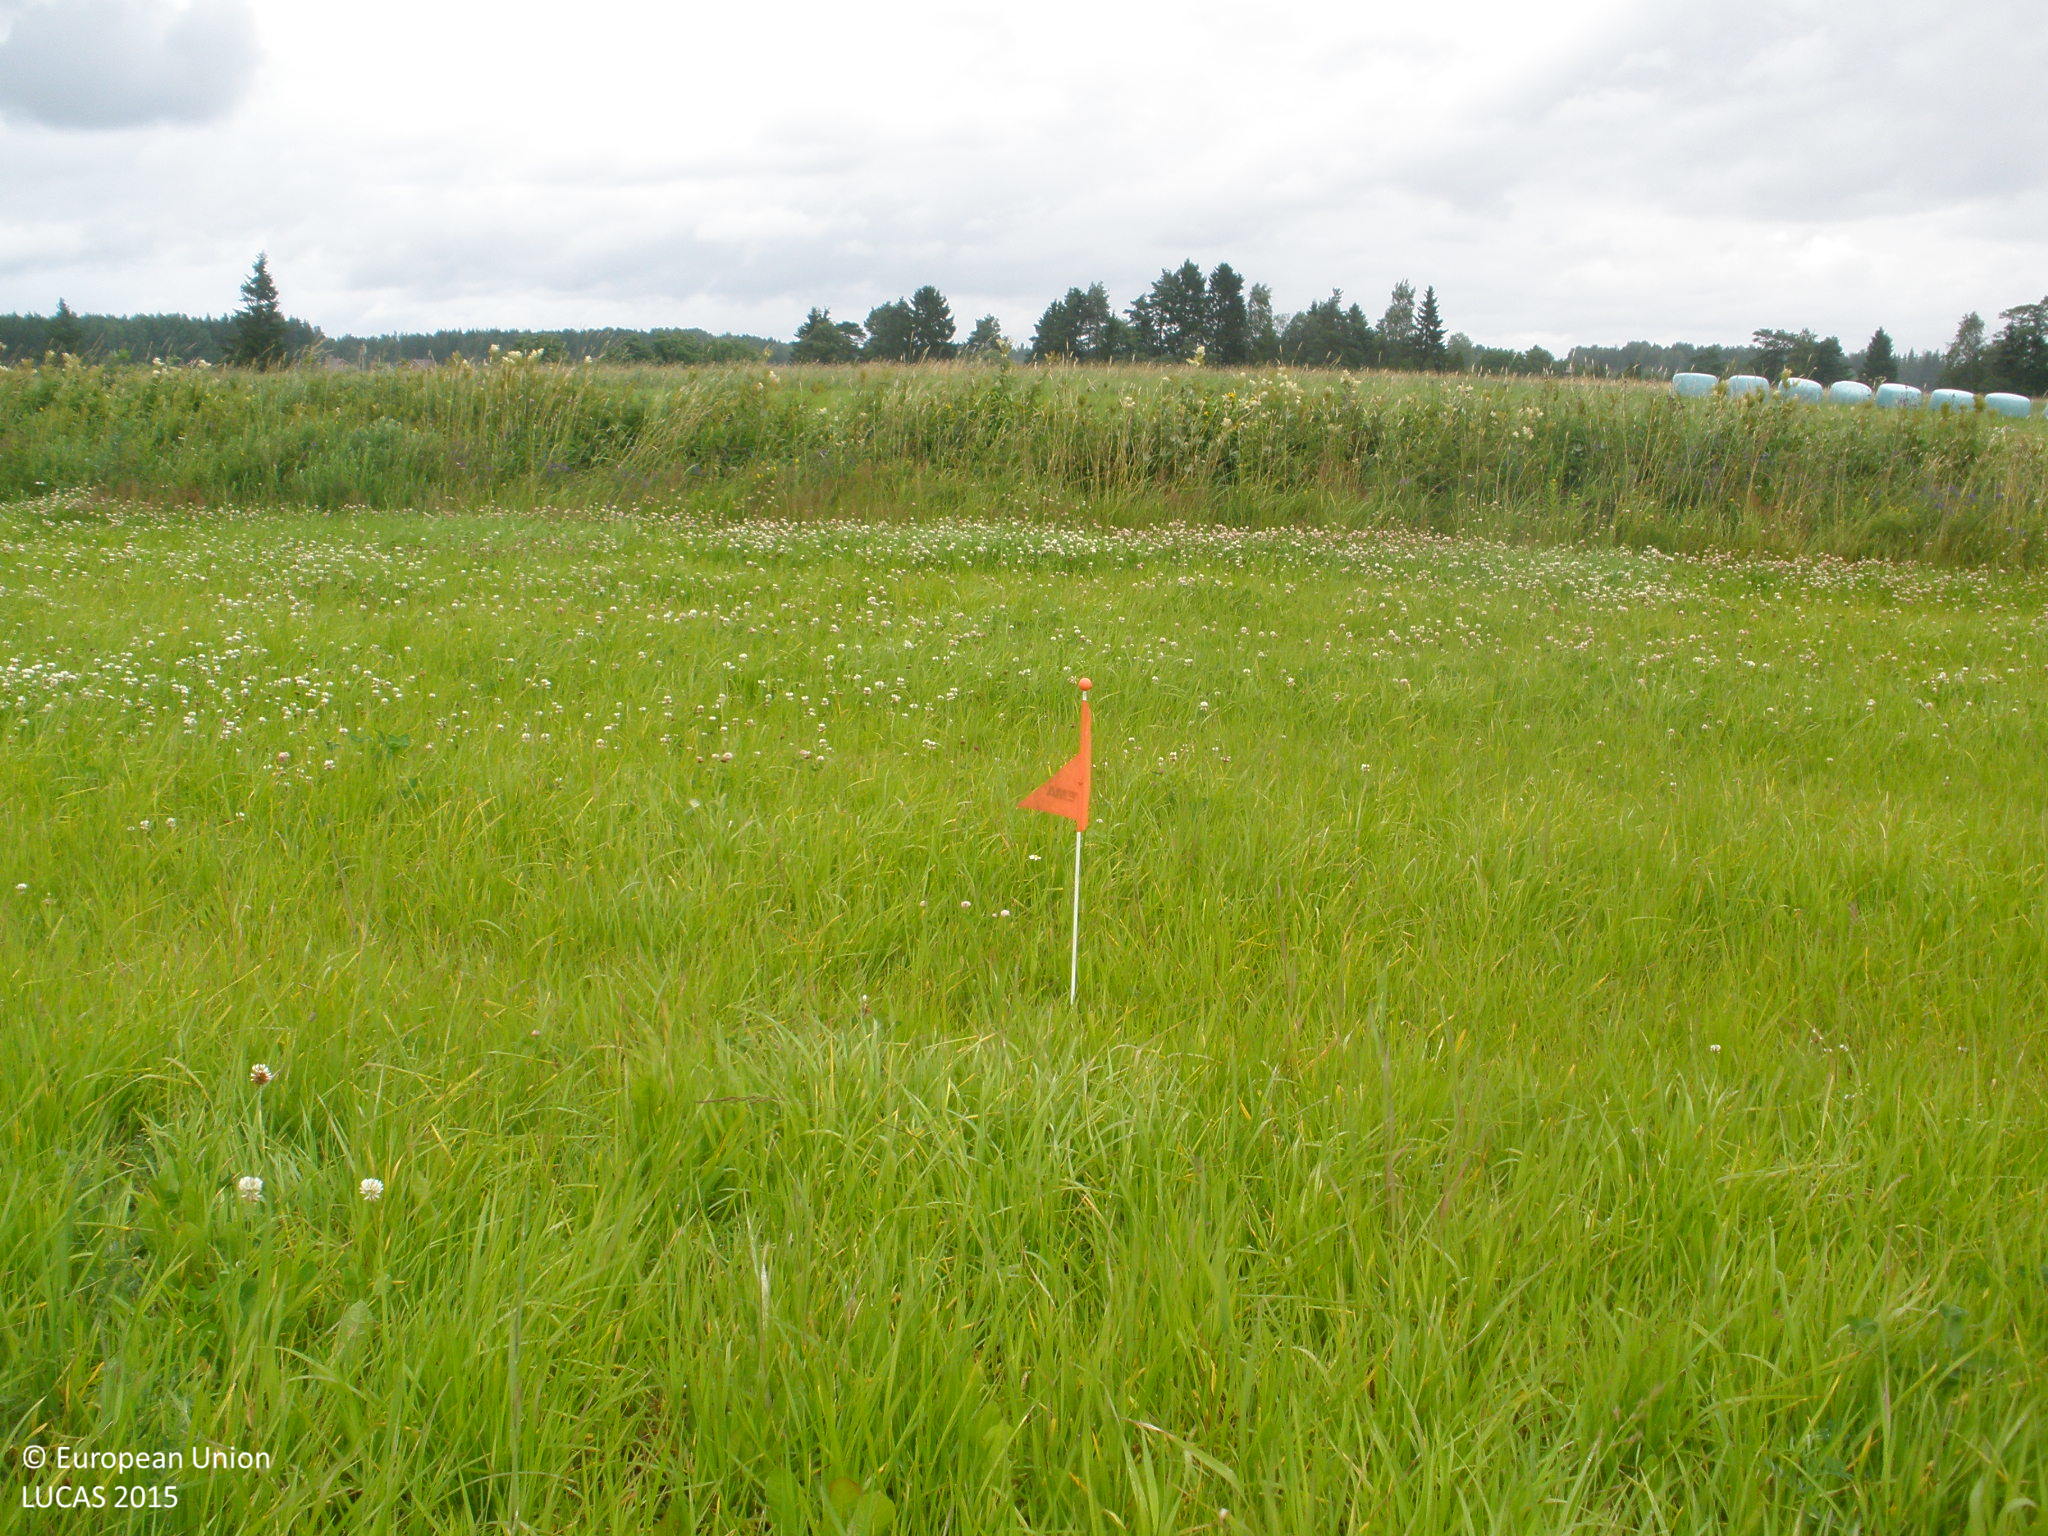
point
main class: Cropland
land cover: Temporary grasslands
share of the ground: > 75 %
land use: Agriculture (excluding fallow land and kitchen gardens)
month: July
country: FI
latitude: 60.5464
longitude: 23.3750
